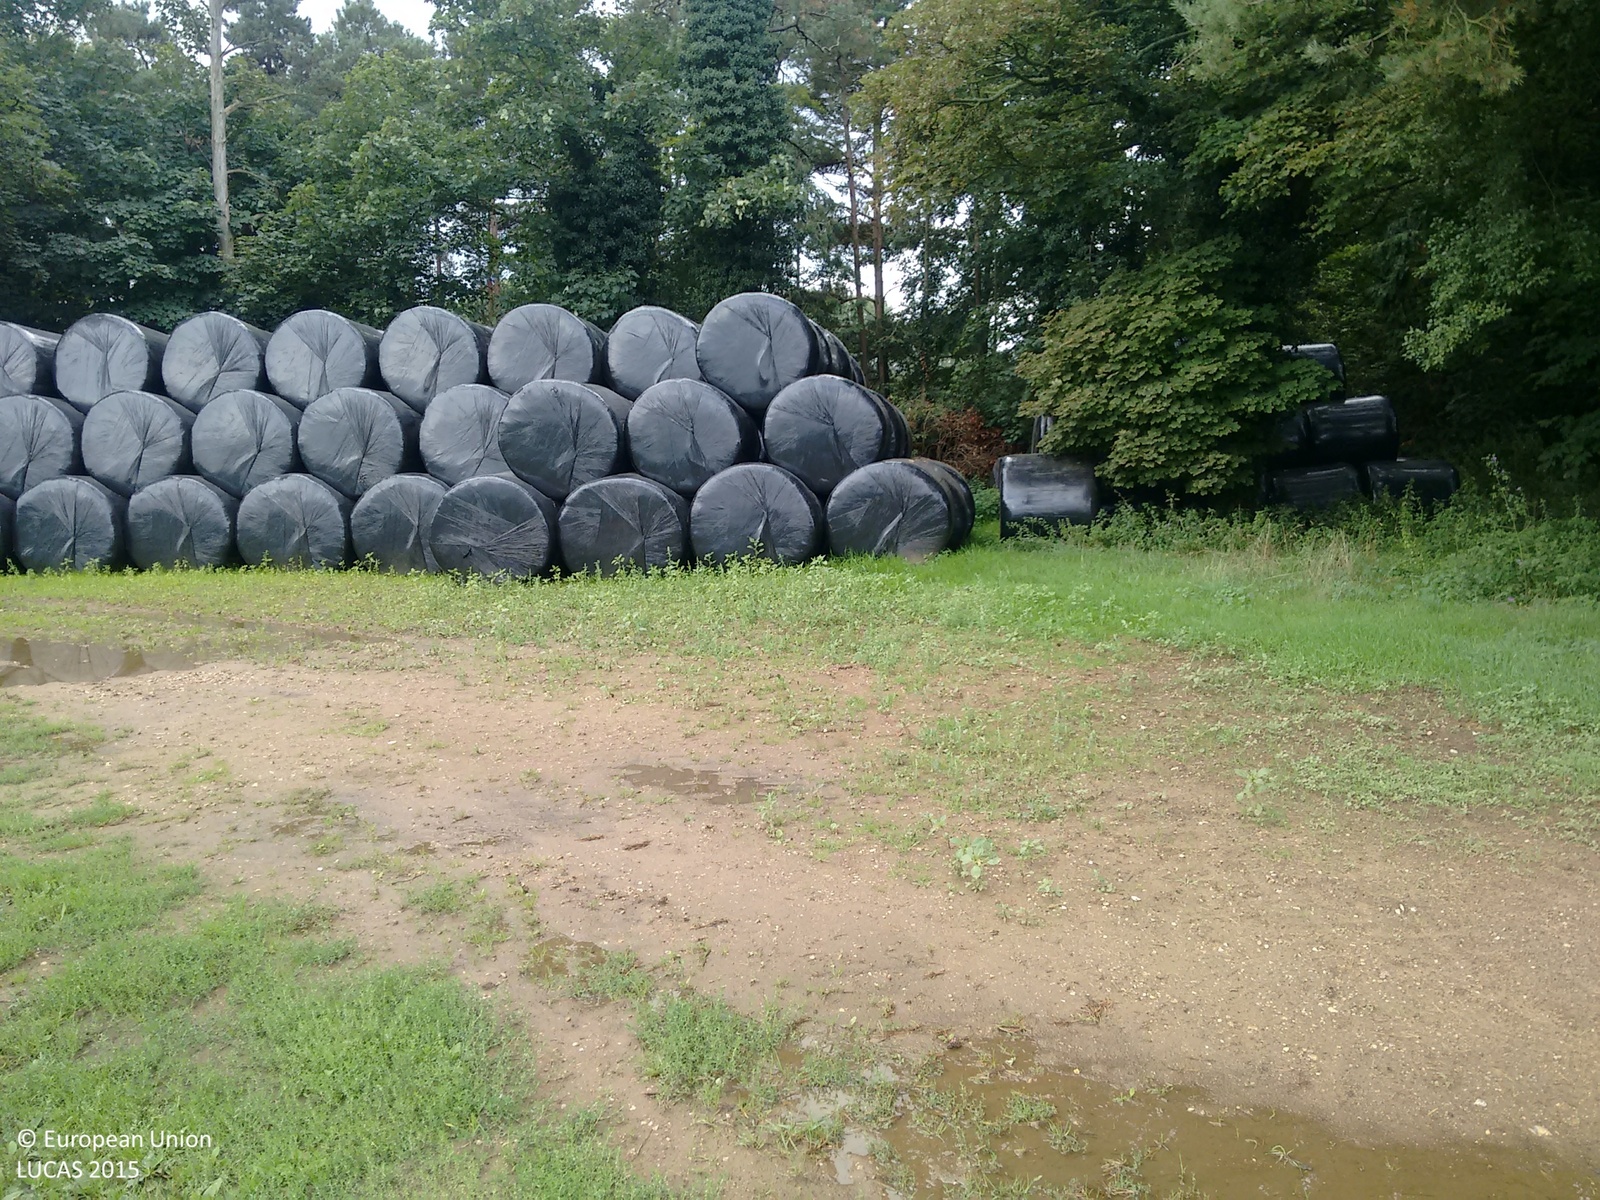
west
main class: Grassland
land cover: Grassland without tree/shrub cover
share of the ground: > 75 %
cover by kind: herbaceous plants 100 %
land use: Agriculture (excluding fallow land and kitchen gardens)
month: September
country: GB
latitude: 52.2999
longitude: 0.4549
